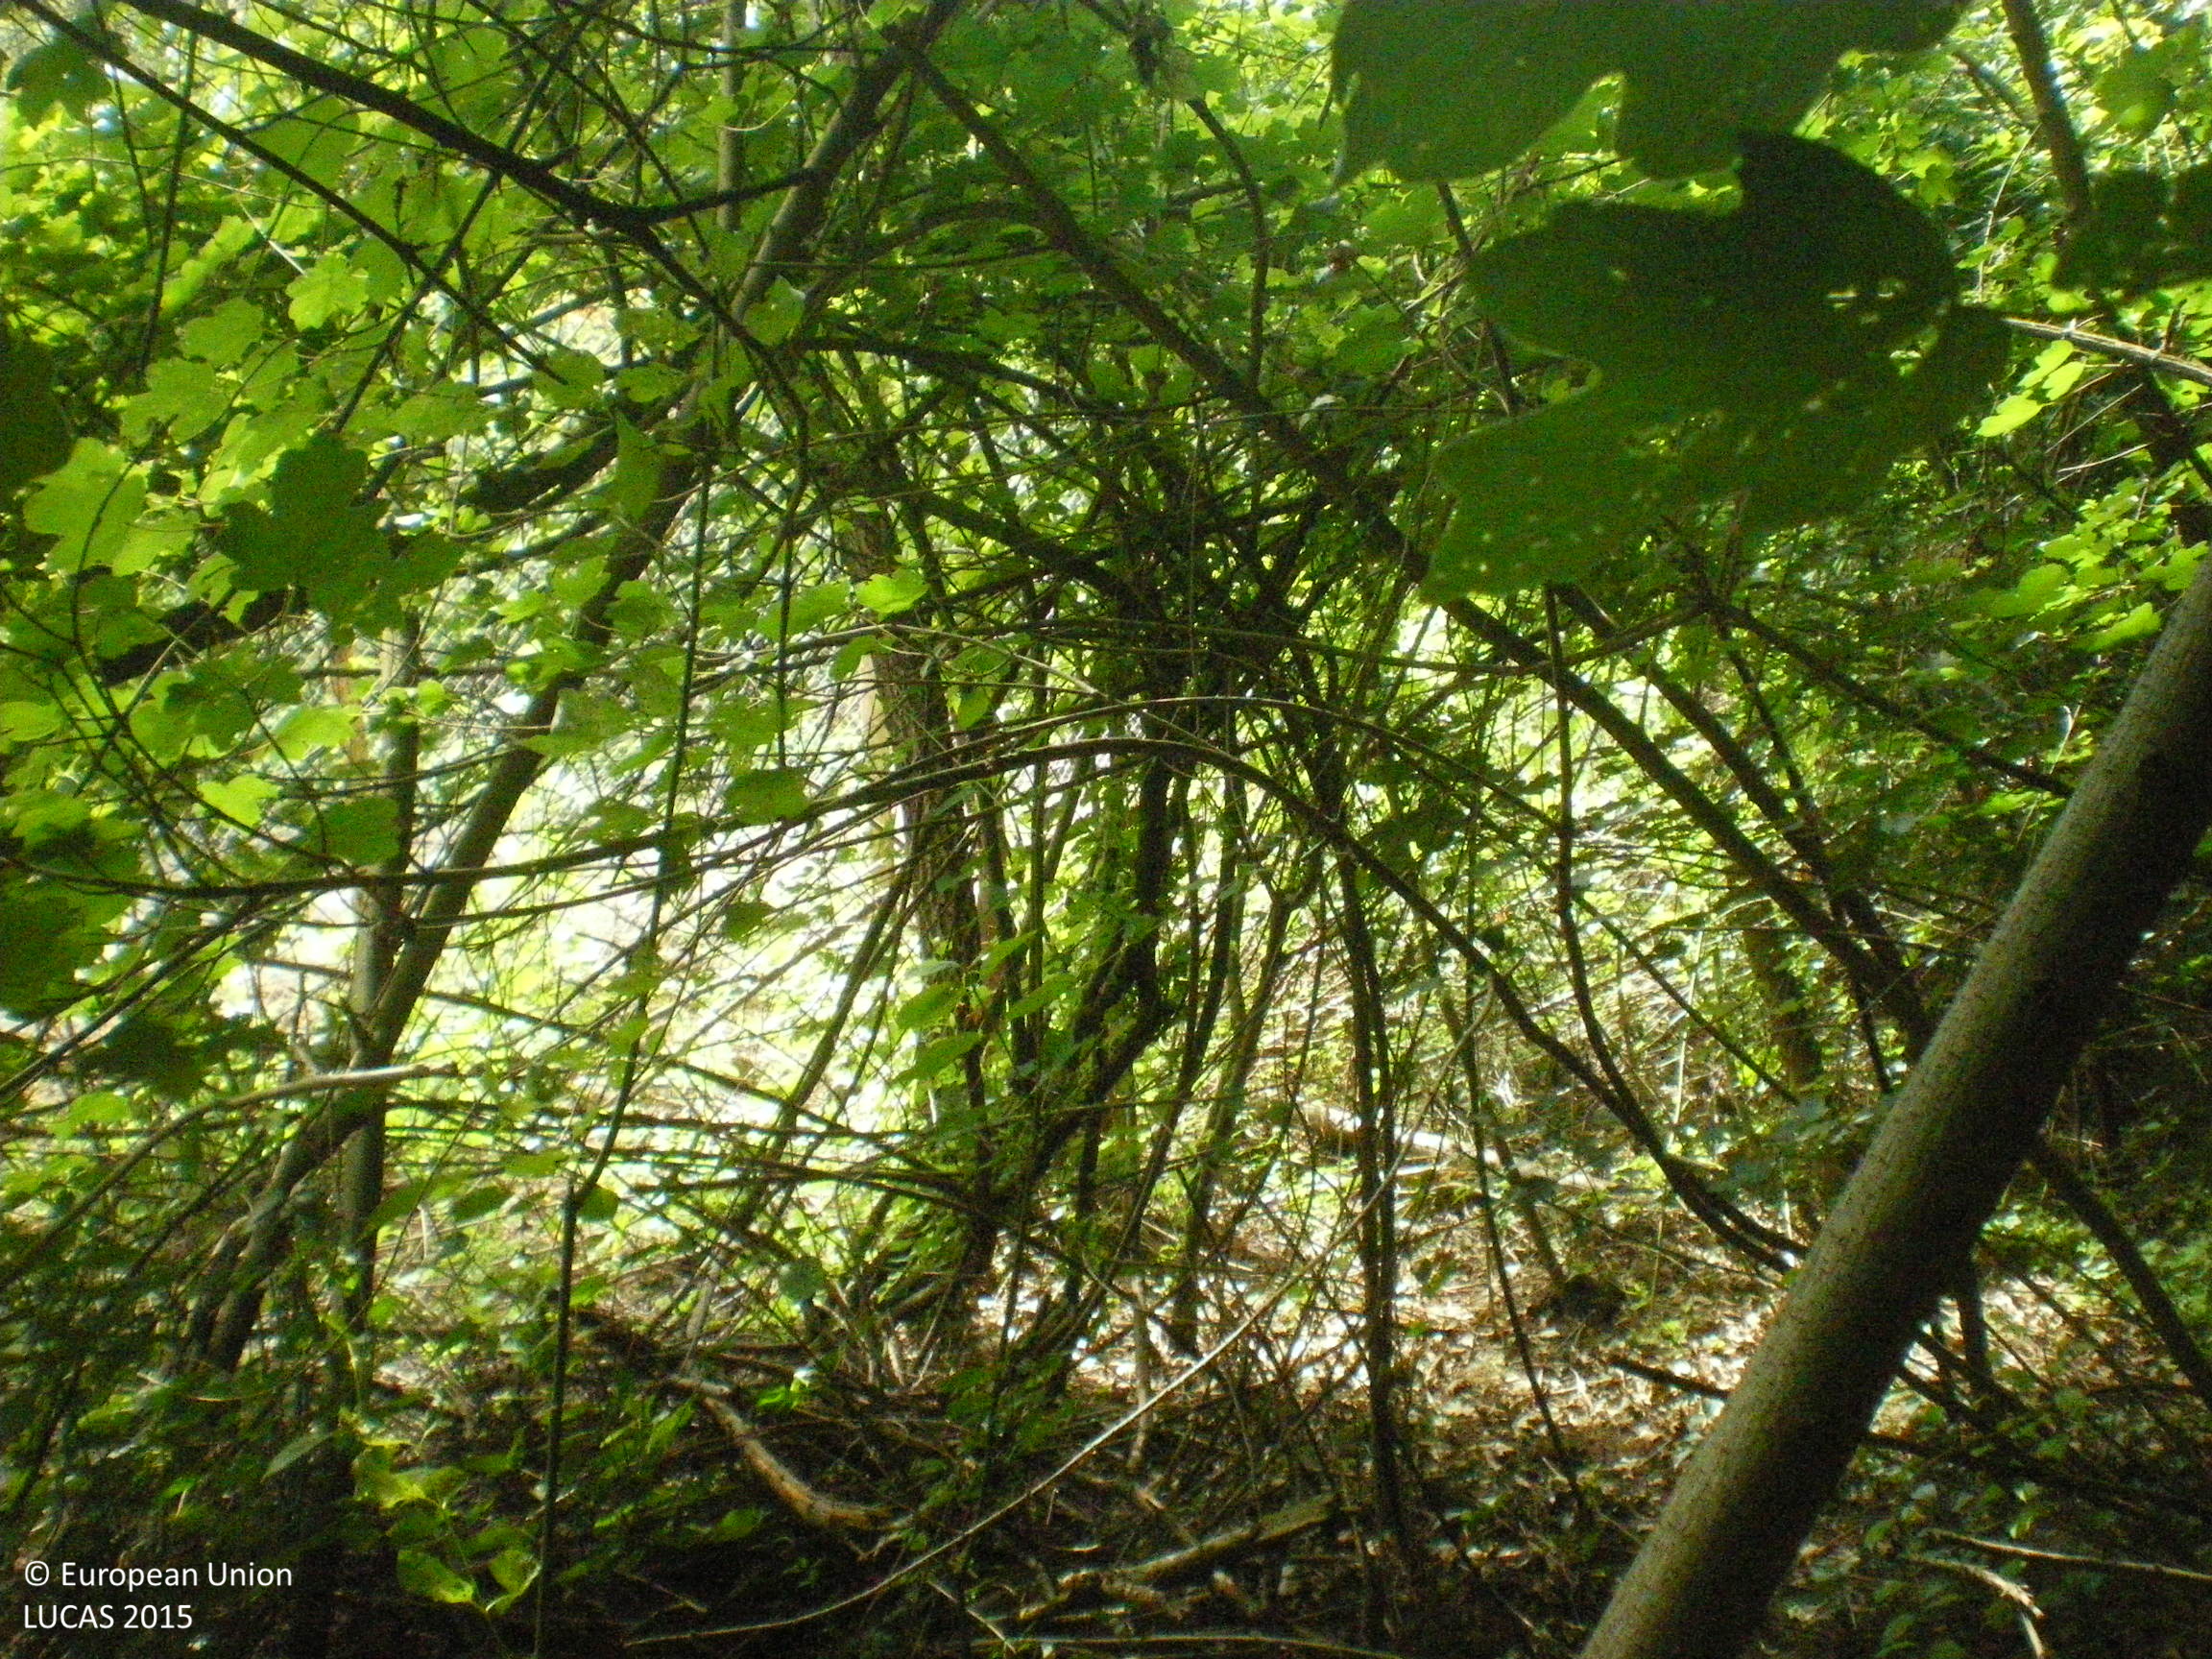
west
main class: Woodland
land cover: Broadleaved woodland
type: mesophytic deciduous forest
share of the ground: > 75 %
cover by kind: broadleaved forest trees 90 %, shrubs 10 %
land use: Forestry
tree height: > 5 m
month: June
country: BG
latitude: 42.1453
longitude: 25.1727
